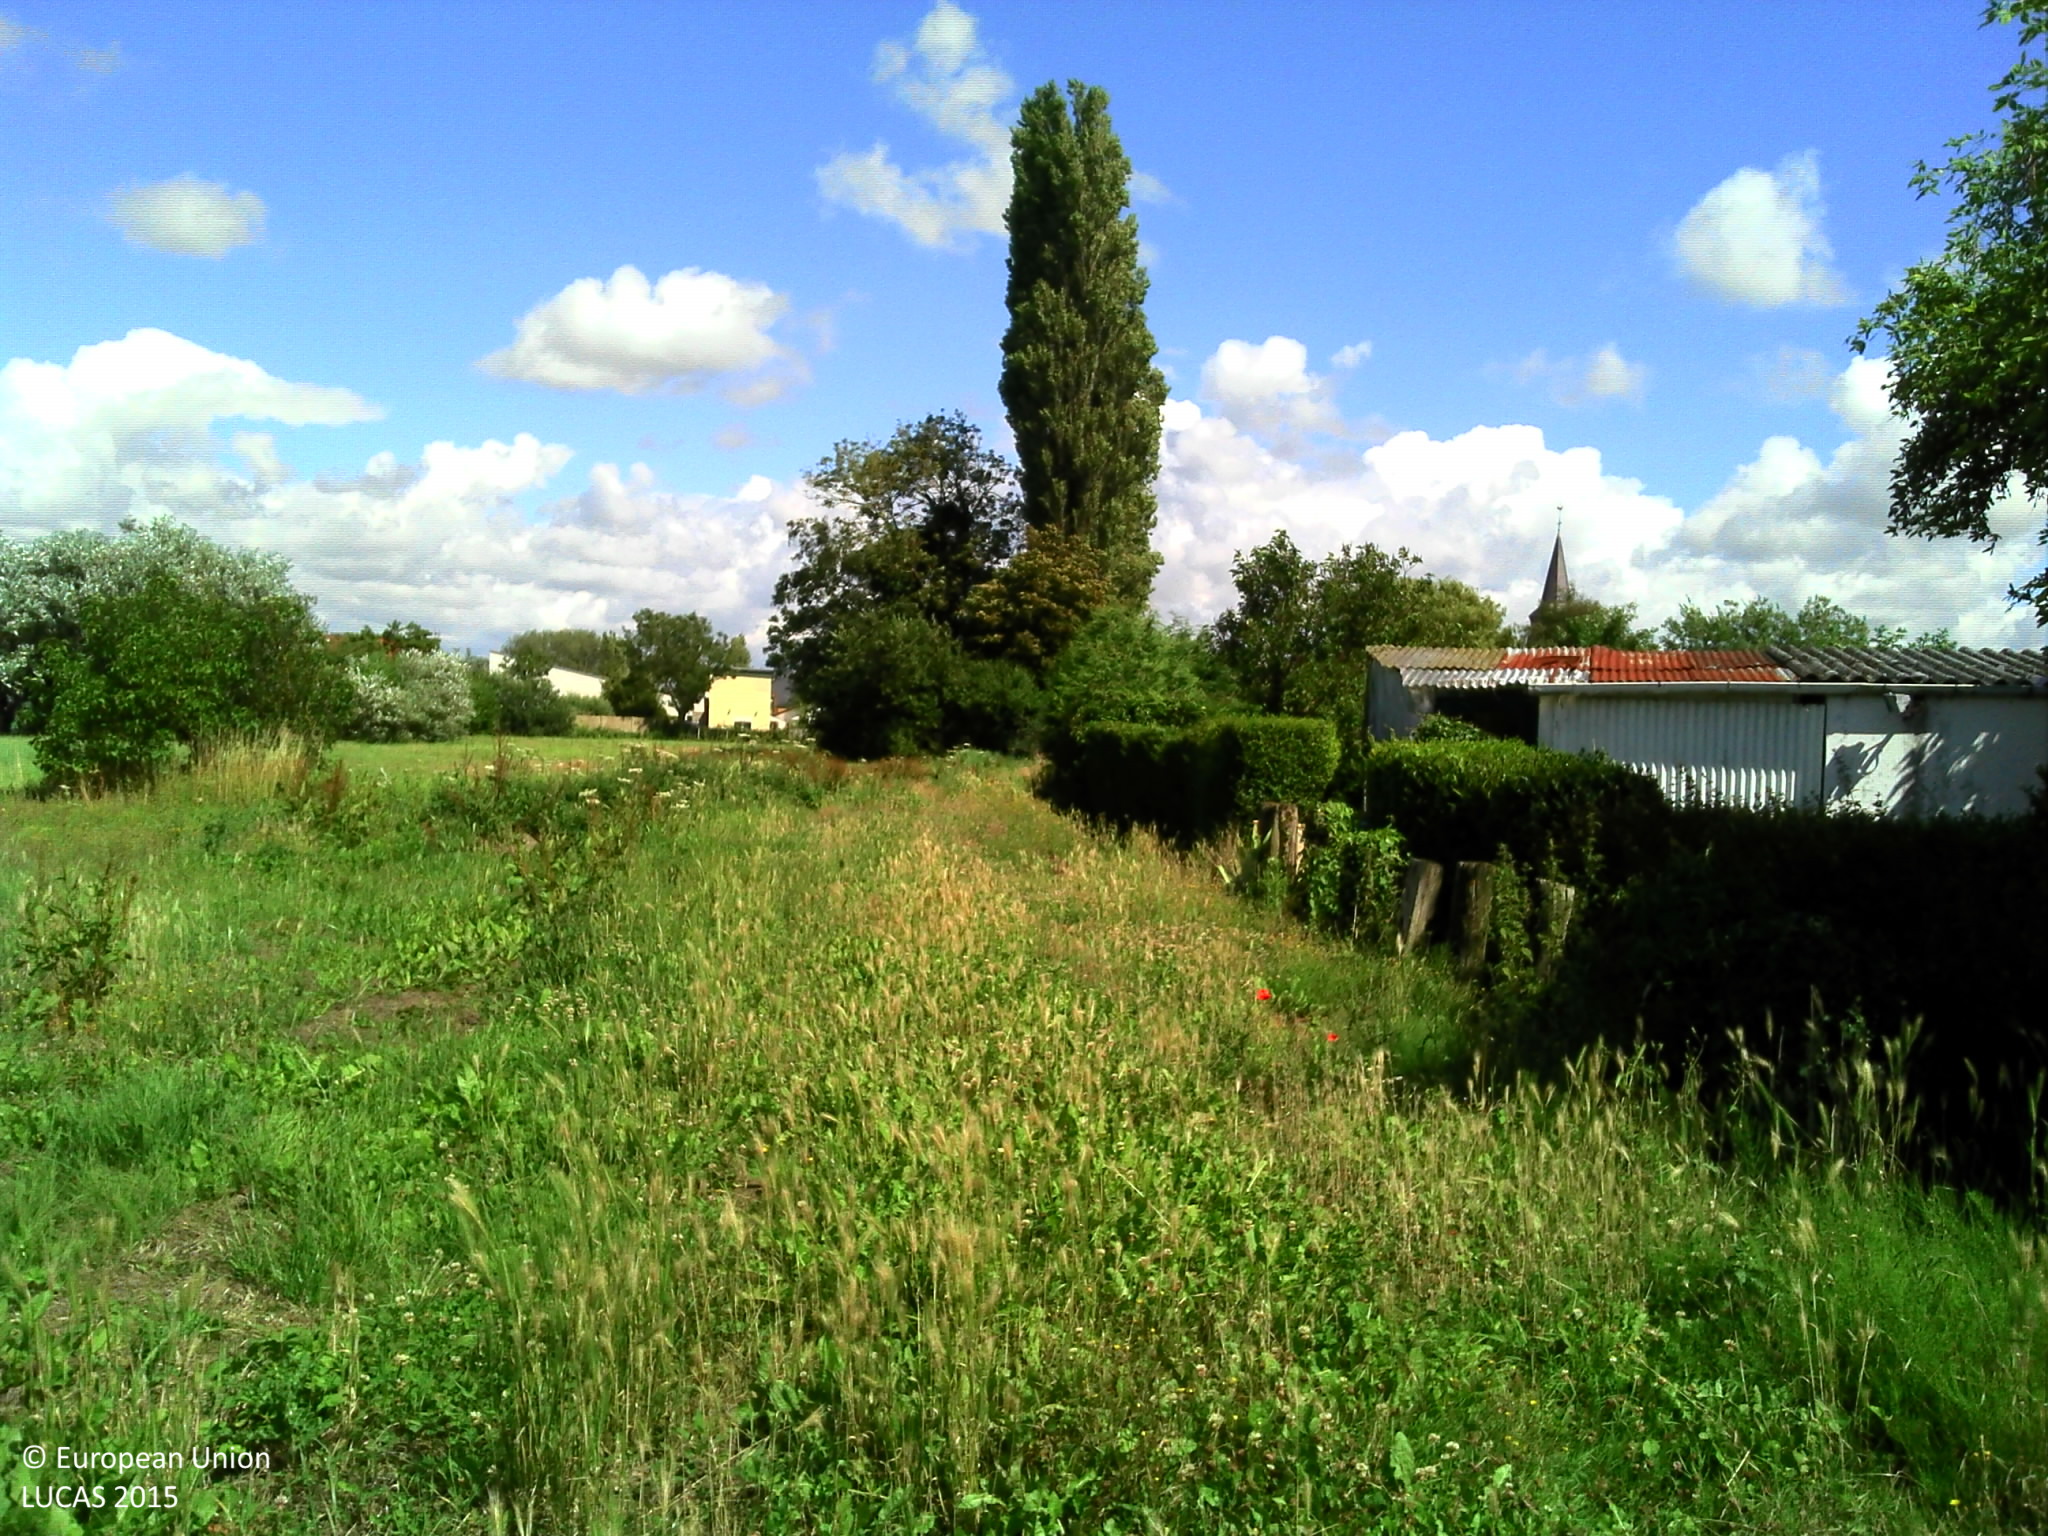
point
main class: Grassland
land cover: Spontaneously vegetated surfaces
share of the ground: > 75 %
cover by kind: herbaceous plants 100 %
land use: Semi-natural and natural areas not in use
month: July
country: FR
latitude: 50.4189
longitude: 1.6358
